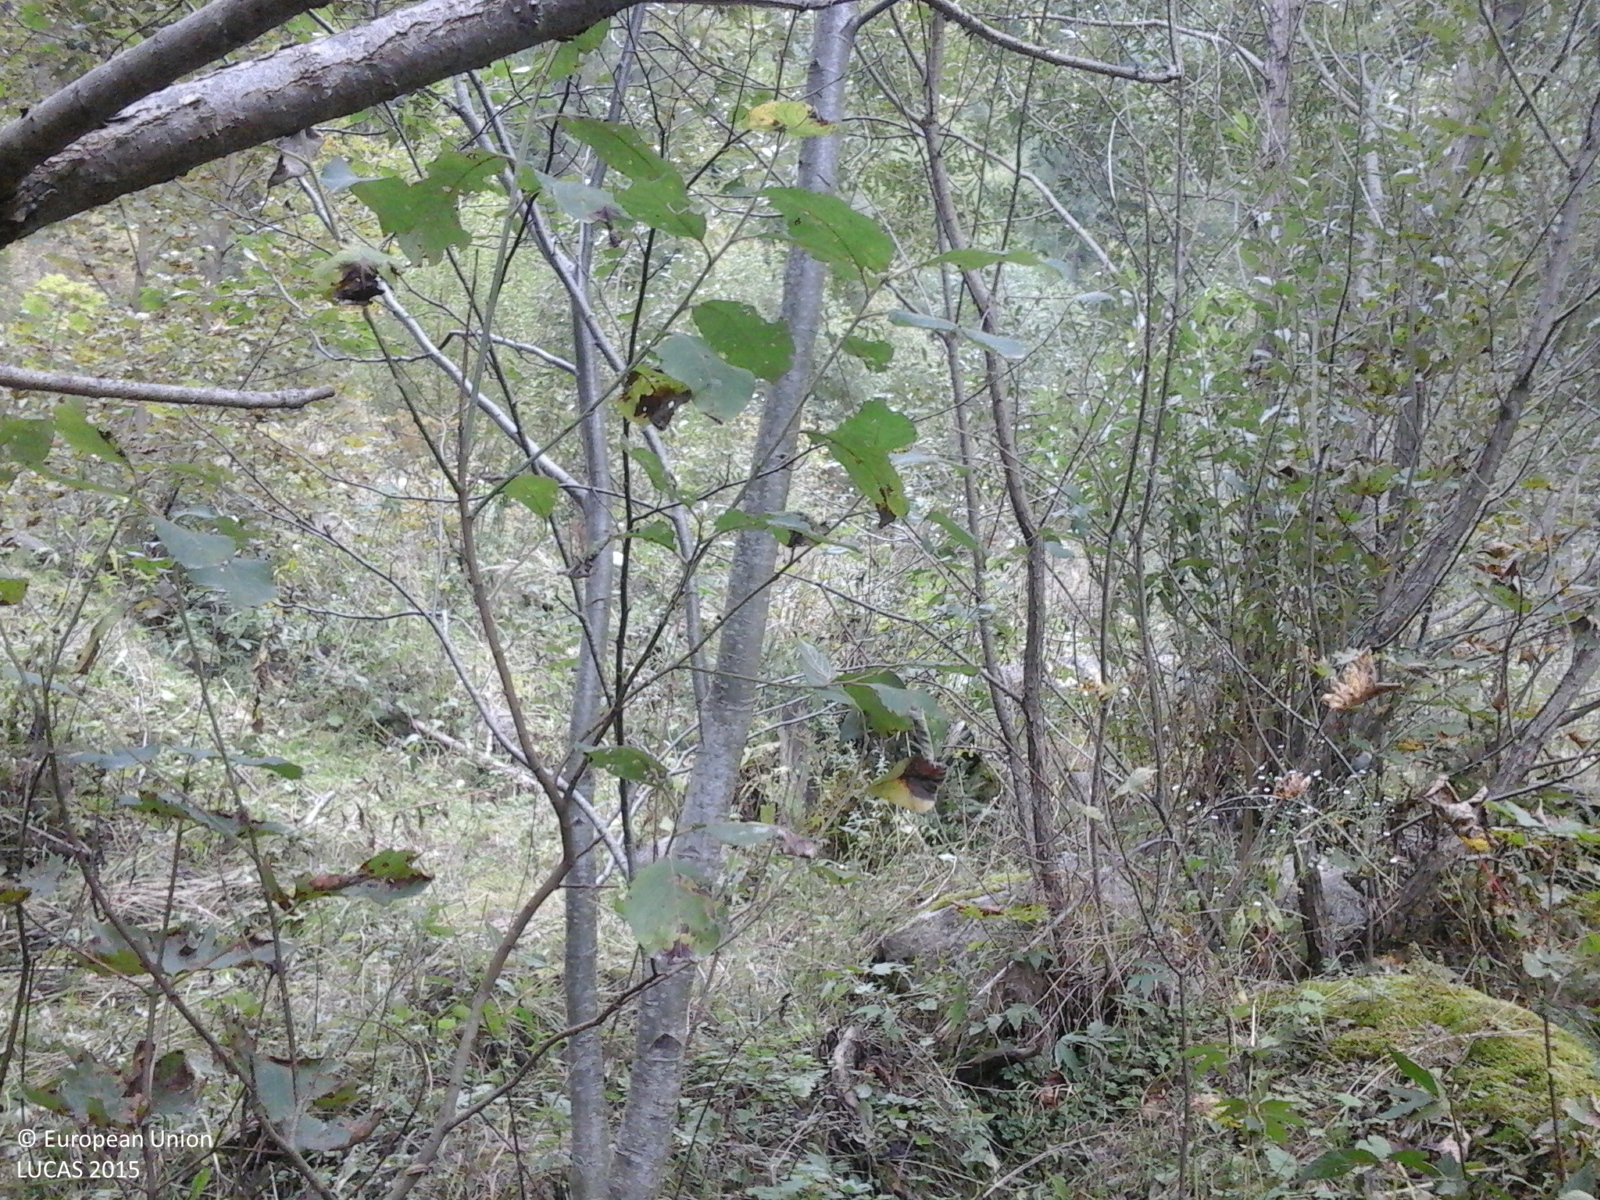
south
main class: Woodland
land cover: Broadleaved woodland
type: exotic forest
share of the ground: > 75 %
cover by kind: broadleaved forest trees 100 %
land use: Forestry
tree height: > 5 m
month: October
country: RO
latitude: 46.6279
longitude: 23.1628
